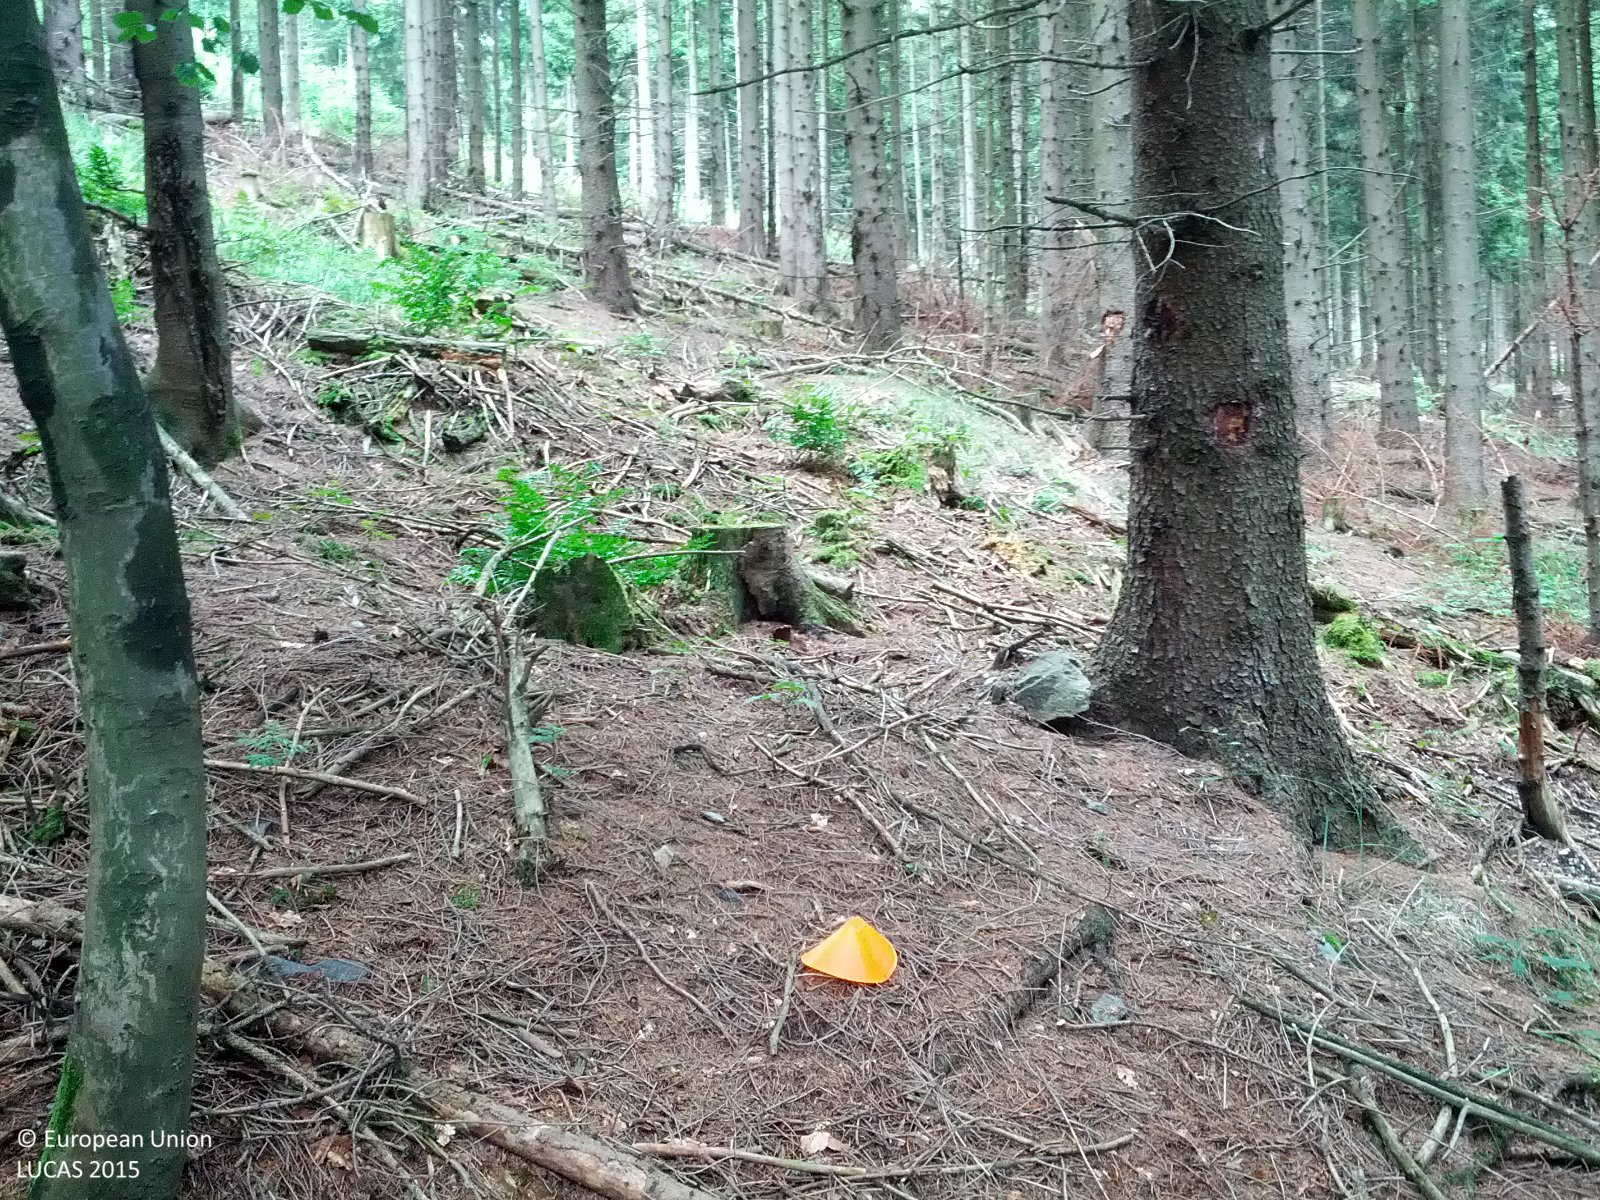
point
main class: Woodland
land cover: Spruce dominated coniferous woodland
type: alpine coniferous forest
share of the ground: > 75 %
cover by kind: coniferous forest trees 90 %, shrubs 5 %, unconsolidated bare surface 5 %
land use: Forestry
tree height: > 5 m
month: July
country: AT
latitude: 47.3501
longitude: 16.4234
